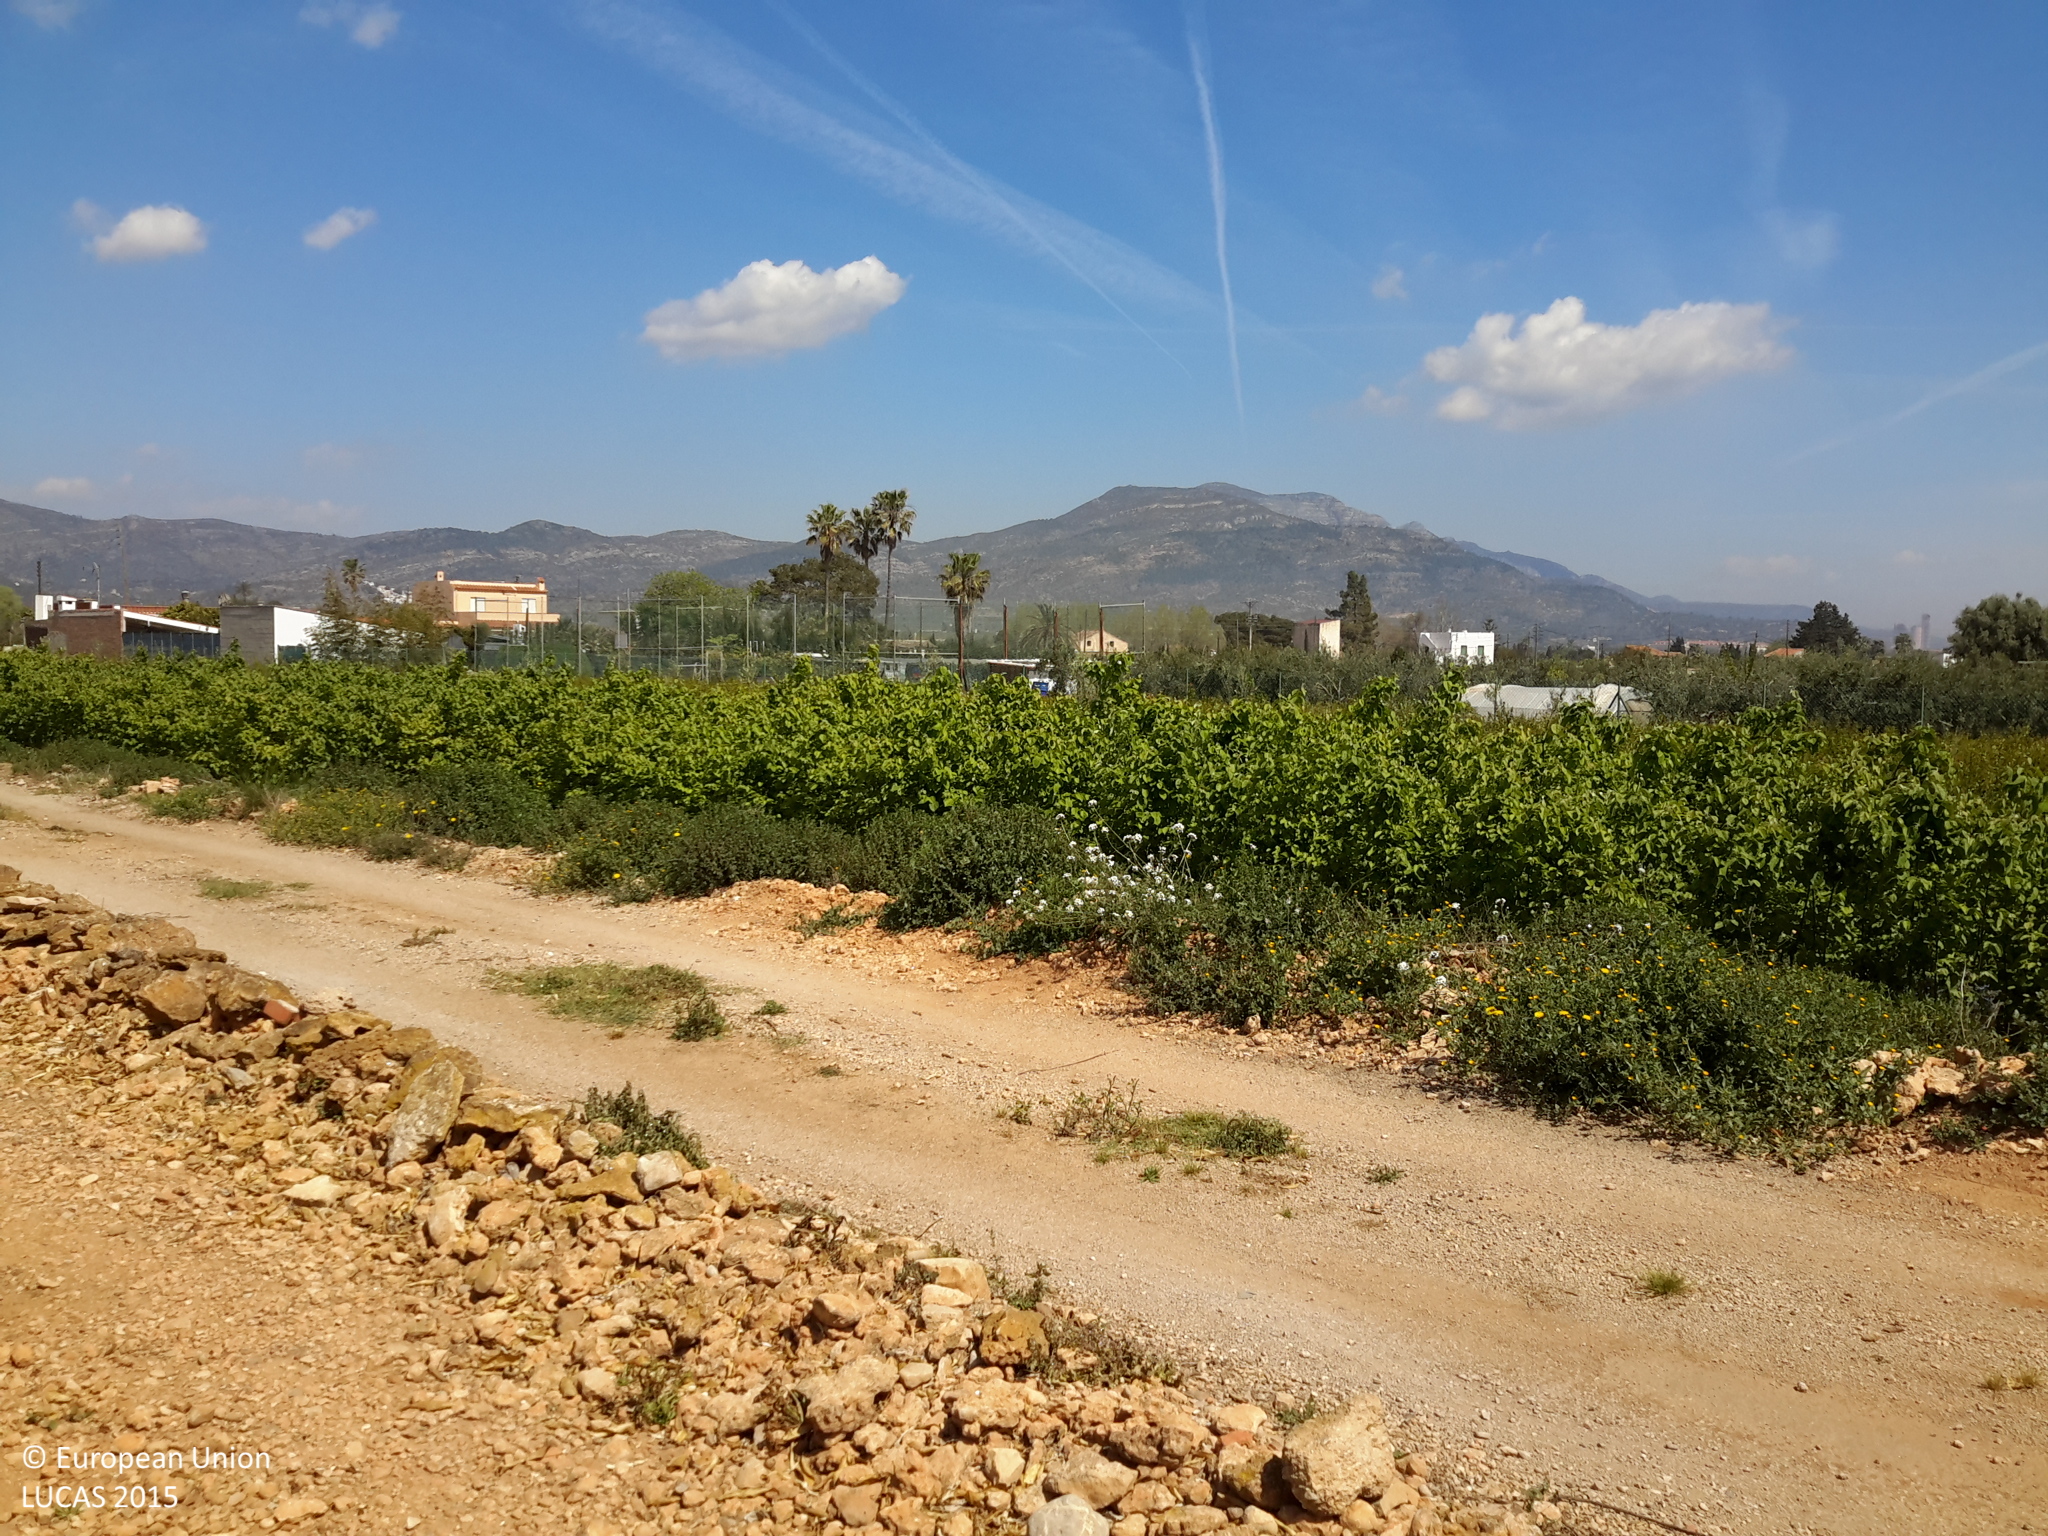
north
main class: Cropland
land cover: Oranges
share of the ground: 50 - 75 %
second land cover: Other bare soil
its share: > 75 %
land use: Agriculture (excluding fallow land and kitchen gardens)
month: April
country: ES
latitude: 40.5351
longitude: 0.5161
